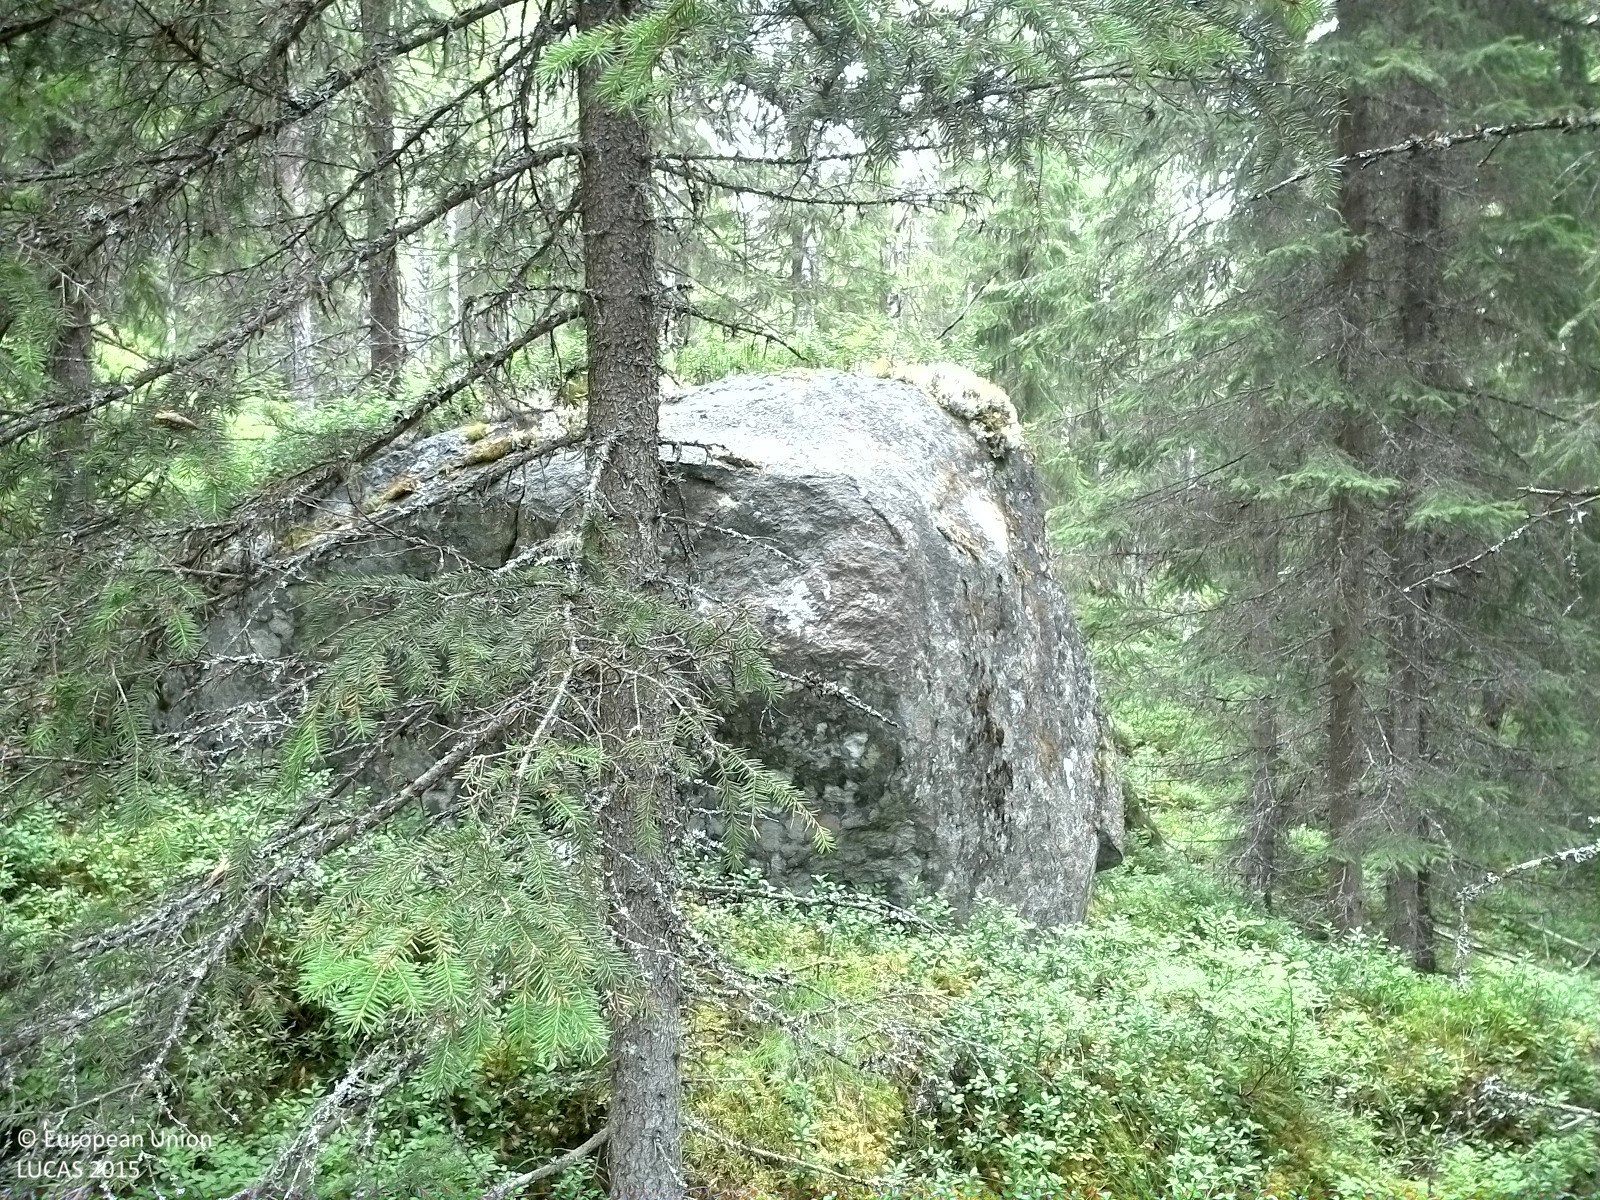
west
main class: Woodland
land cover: Other mixed woodland
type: boreal forest
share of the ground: 50 - 75 %
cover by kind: shrubs 45 %, coniferous forest trees 30 %, broadleaved forest trees 25 %
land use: Forestry
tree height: > 5 m
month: August
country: SE
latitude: 62.8138
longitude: 16.5498
